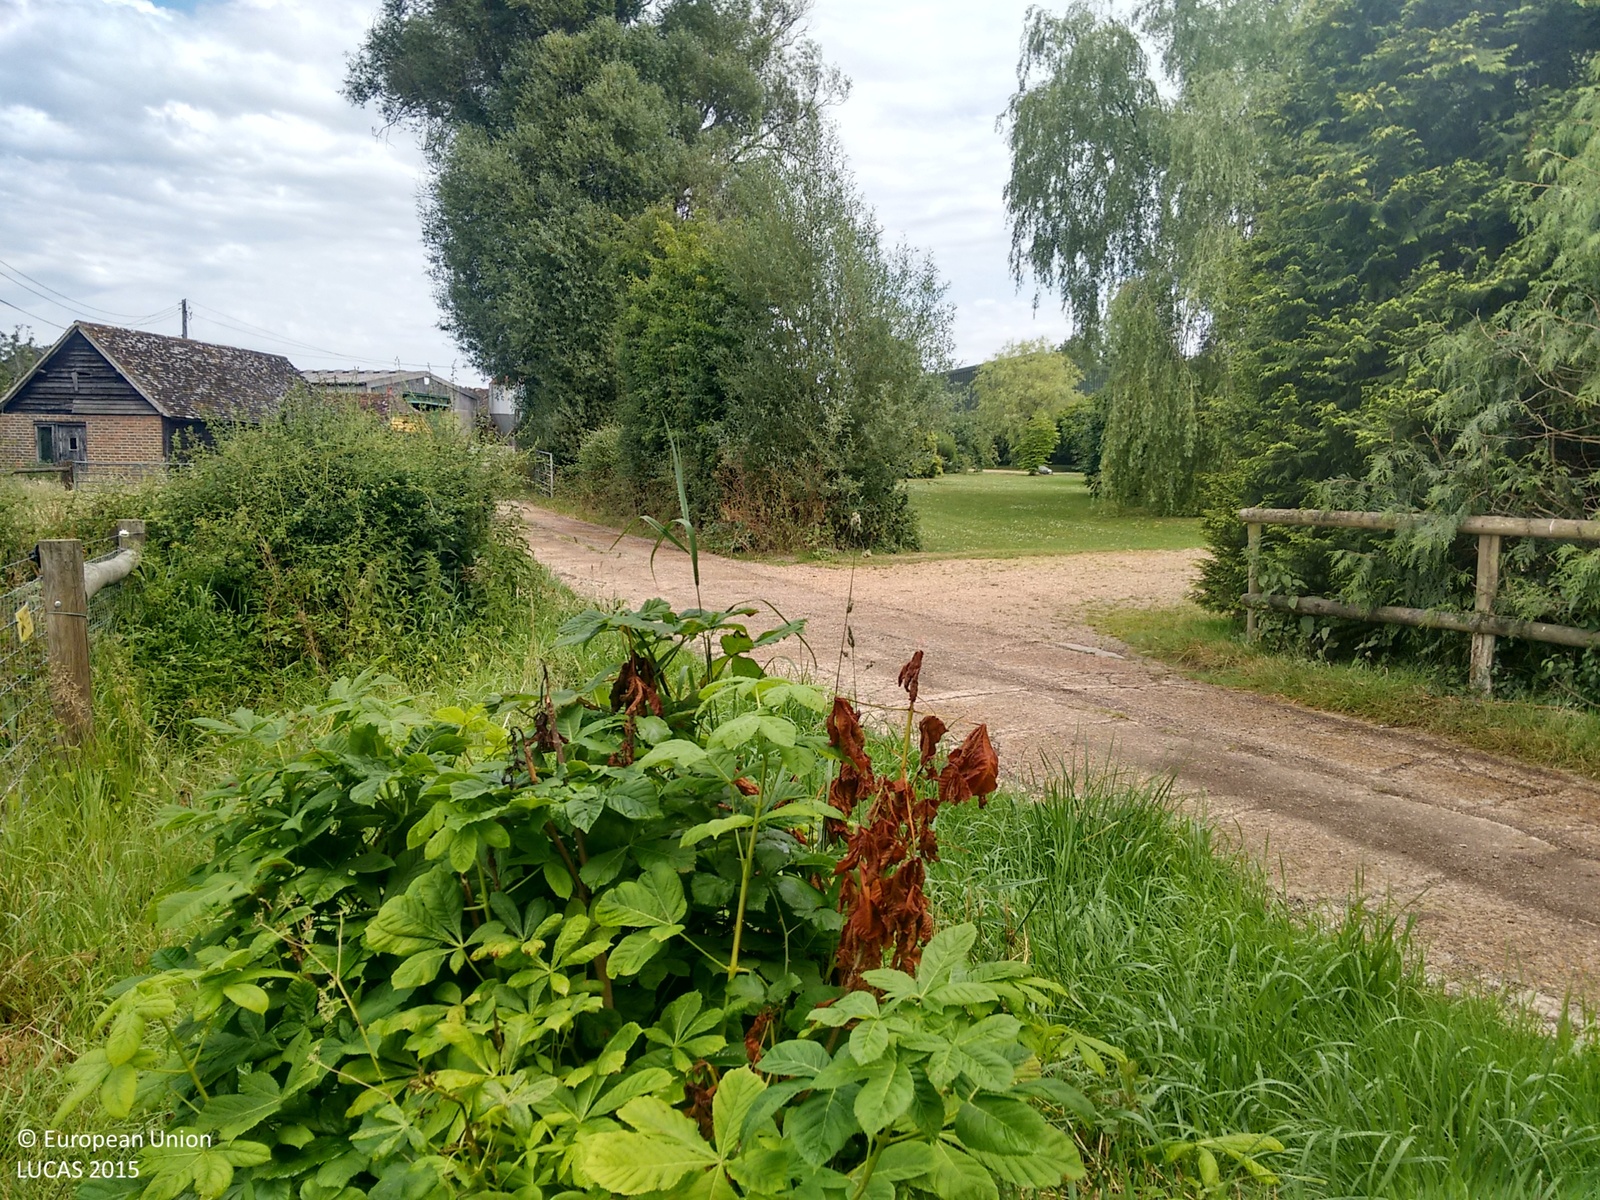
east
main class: Grassland
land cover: Grassland without tree/shrub cover
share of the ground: > 75 %
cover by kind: herbaceous plants 100 %
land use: Agriculture (excluding fallow land and kitchen gardens)
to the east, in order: Grassland without tree/shrub cover; Managed hedges; Inland fresh water bodies; Broadleaved woodland; Artificial constructions in urban areas; Grassland without tree/shrub cover; Electric lines; Grassland without tree/shrub cover; Managed hedges; Grassland without tree/shrub cover
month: July
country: GB
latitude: 50.9569
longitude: -0.2142
